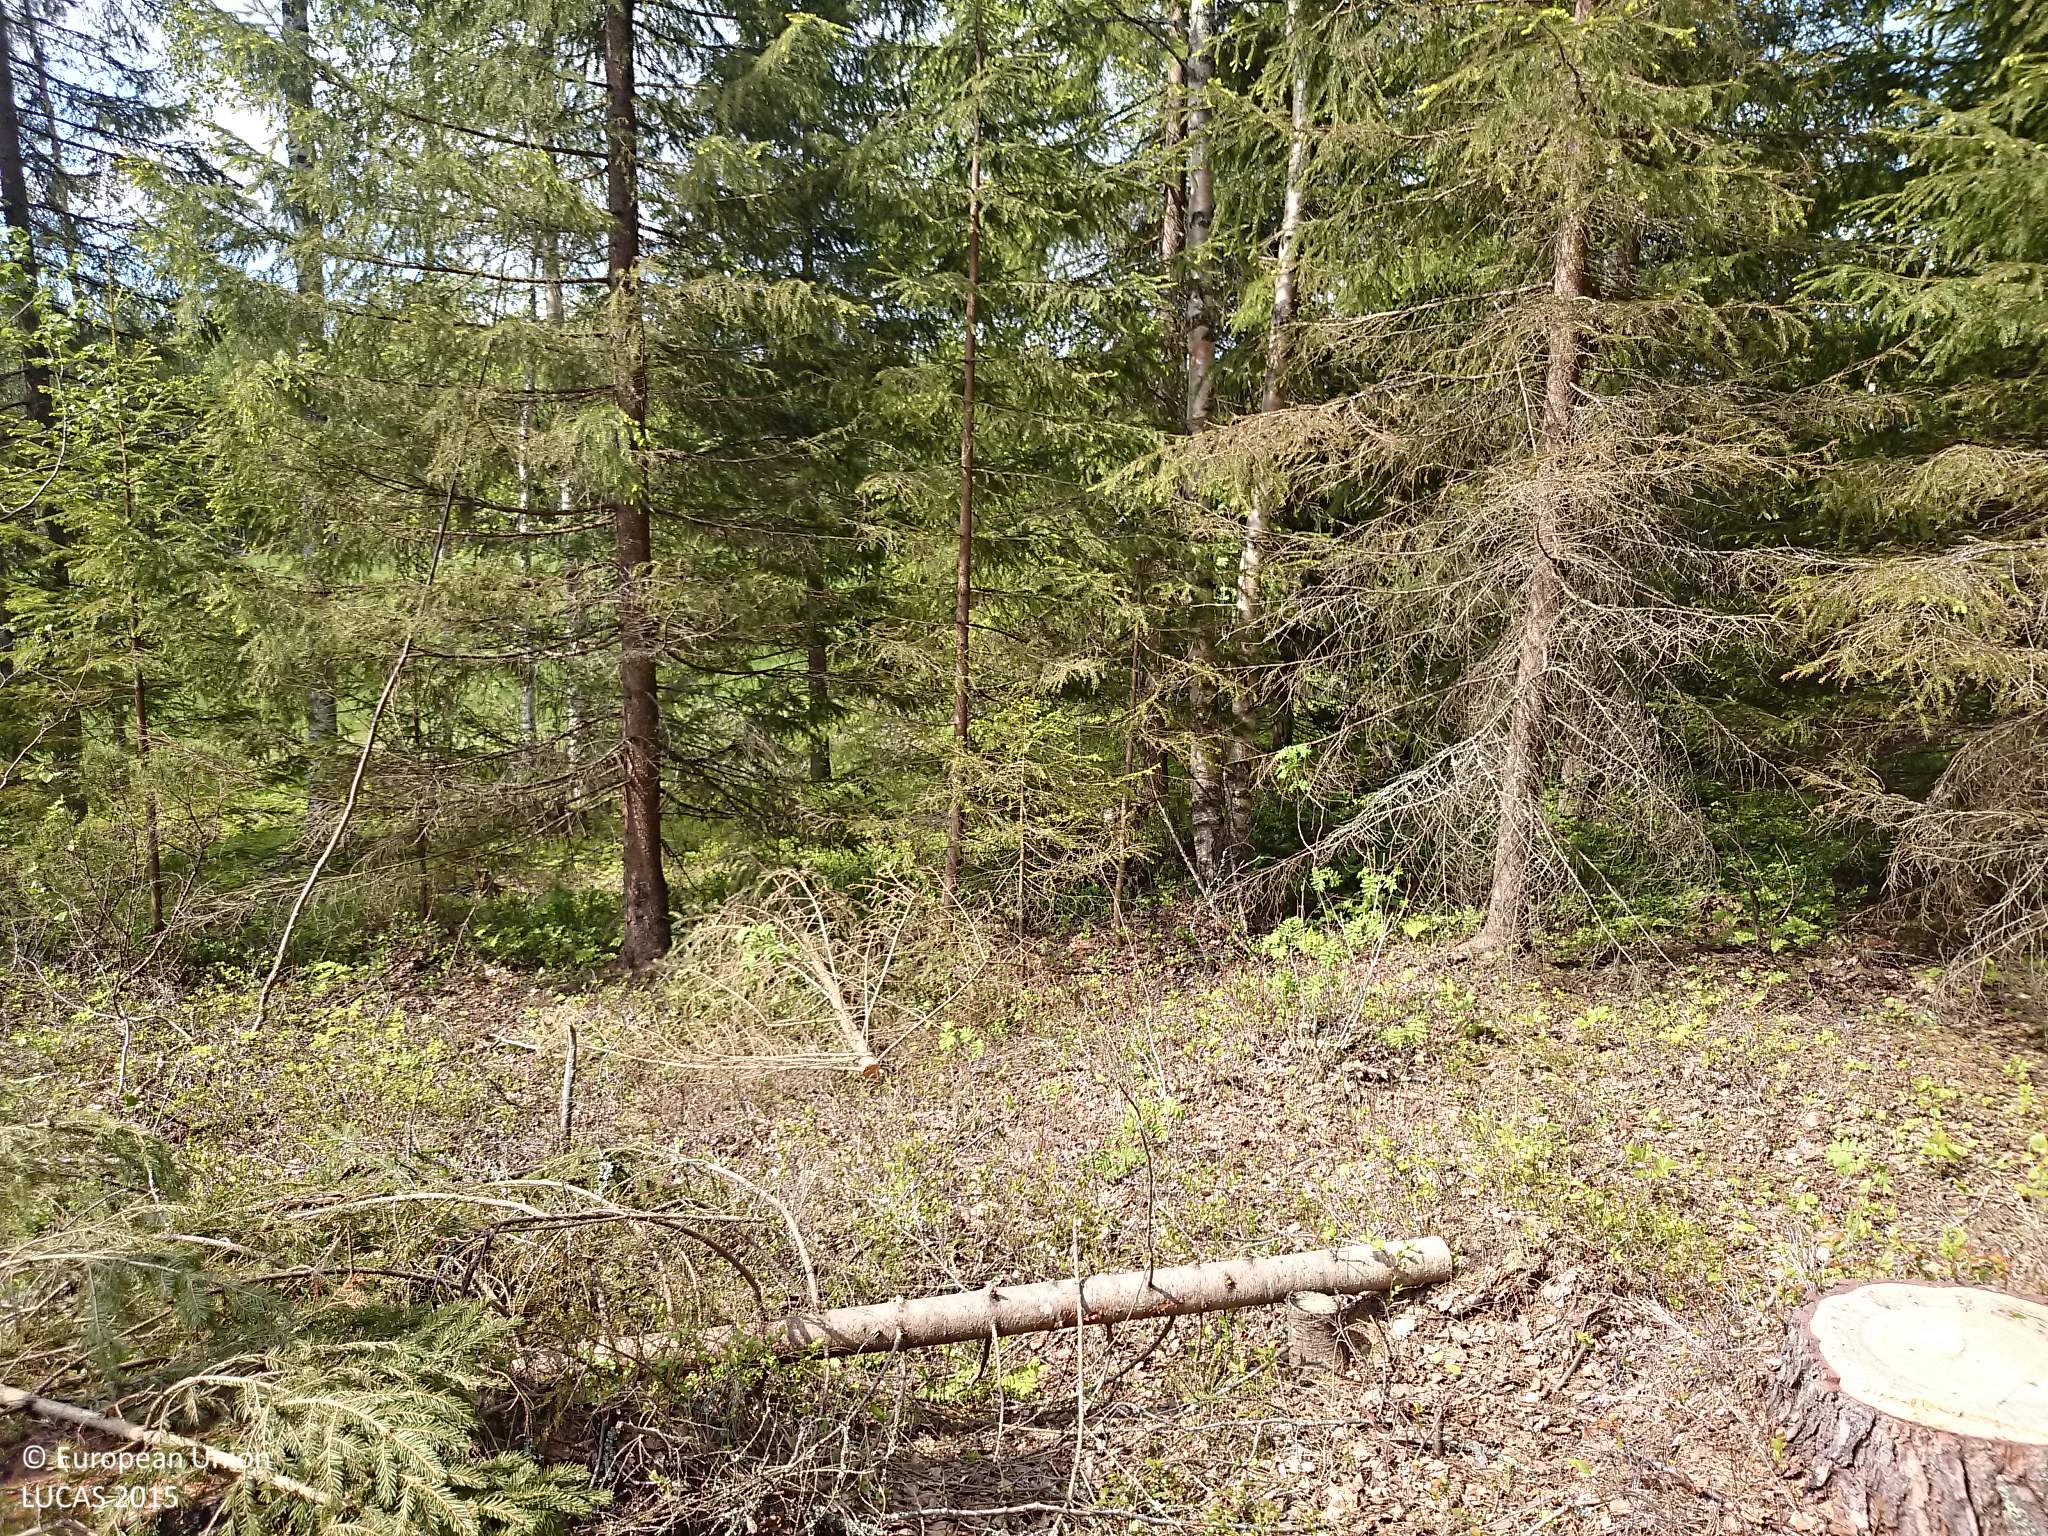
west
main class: Shrubland
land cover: Shrubland with sparse tree cover
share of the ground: 50 - 75 %
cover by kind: shrubs 45 %, herbaceous plants 10 %, broadleaved forest trees 5 %, lichens and mosses 5 %
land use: Forestry
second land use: Amenities, museums, leisure
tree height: > 5 m
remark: Clear cut
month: June
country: SE
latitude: 64.0177
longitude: 20.1474
